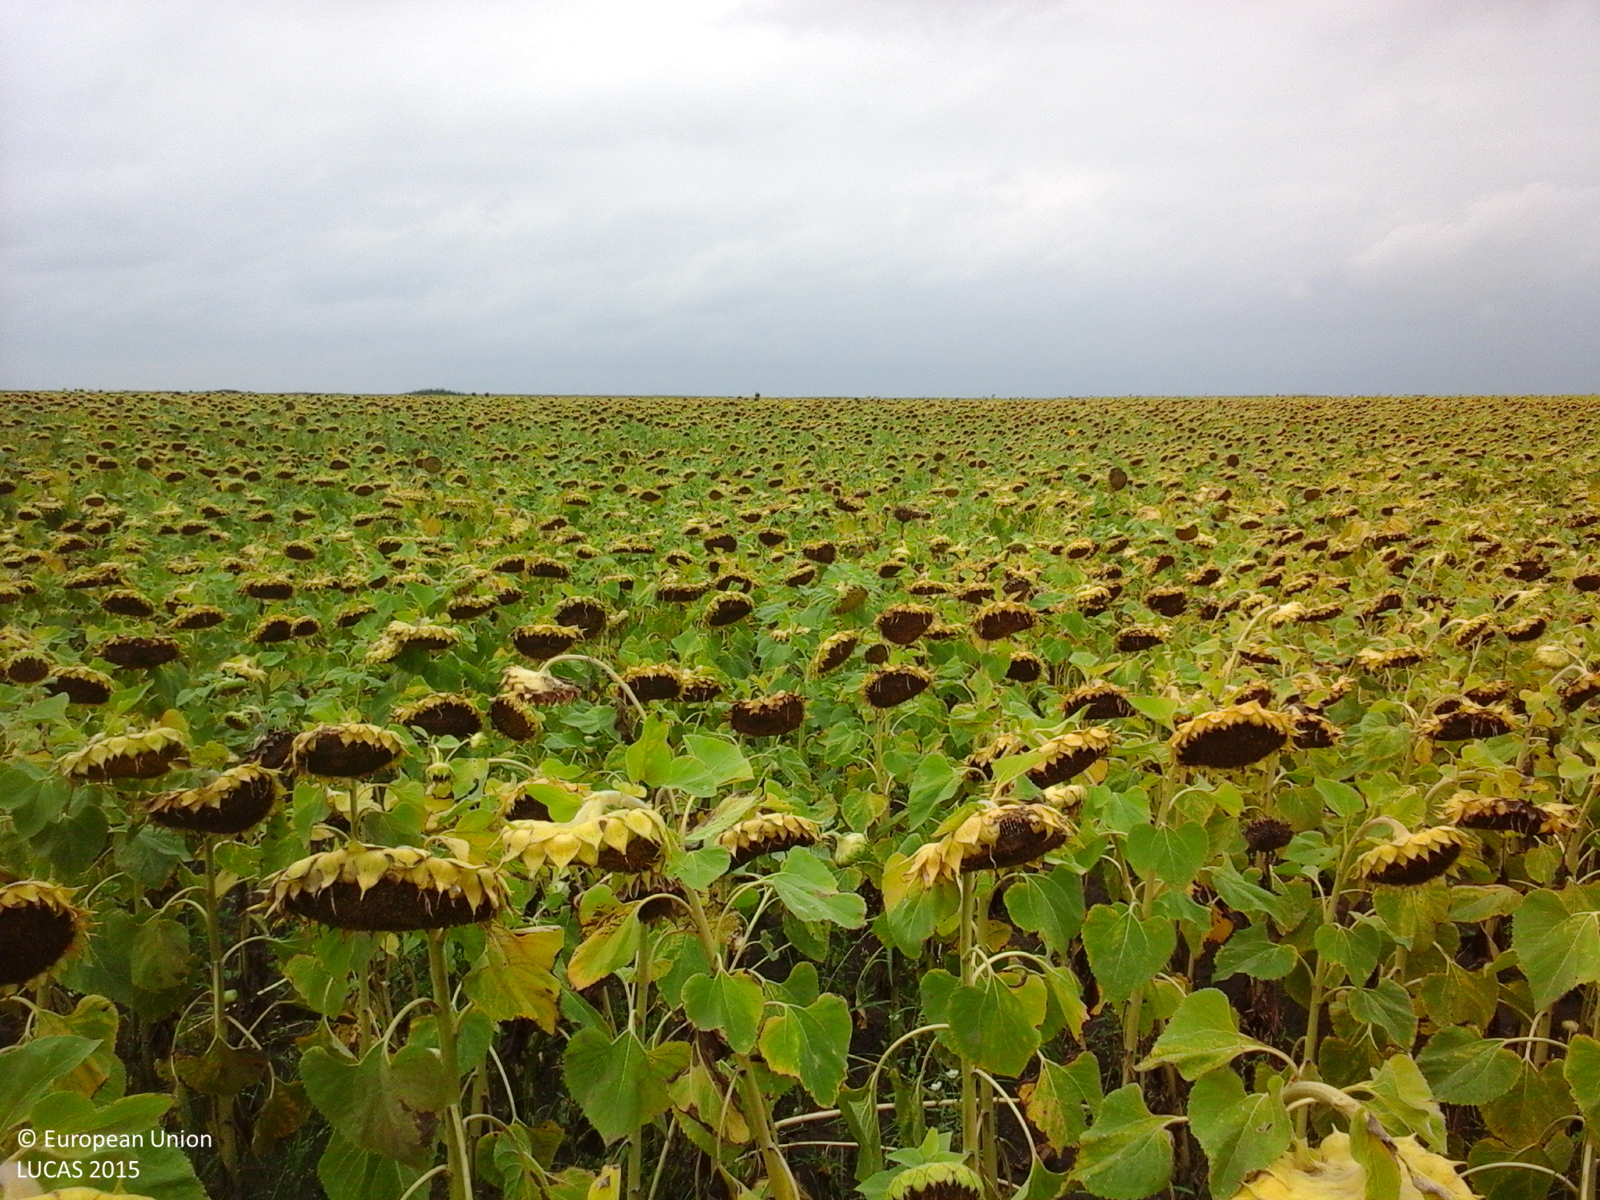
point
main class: Cropland
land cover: Sunflower
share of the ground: > 75 %
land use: Agriculture (excluding fallow land and kitchen gardens)
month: August
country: RO
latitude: 46.0859
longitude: 20.5129
